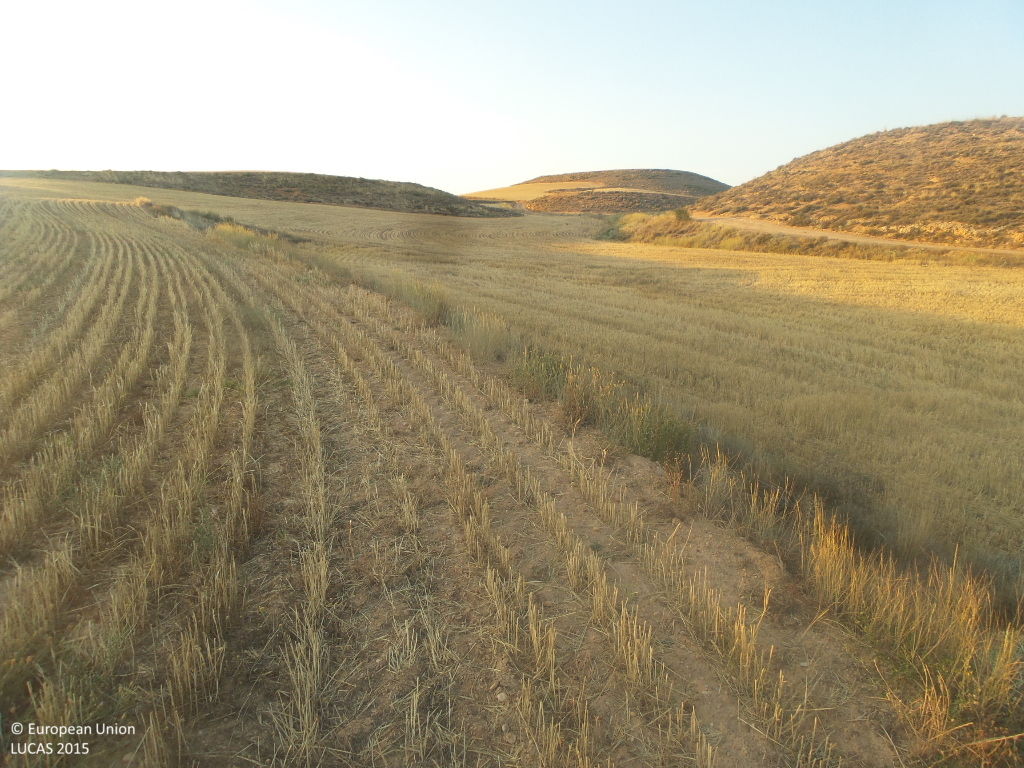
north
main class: Cropland
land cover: Barley
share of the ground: < 10 %
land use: Agriculture (excluding fallow land and kitchen gardens)
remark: Harvested field
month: July
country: ES
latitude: 41.3048
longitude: -2.1043
